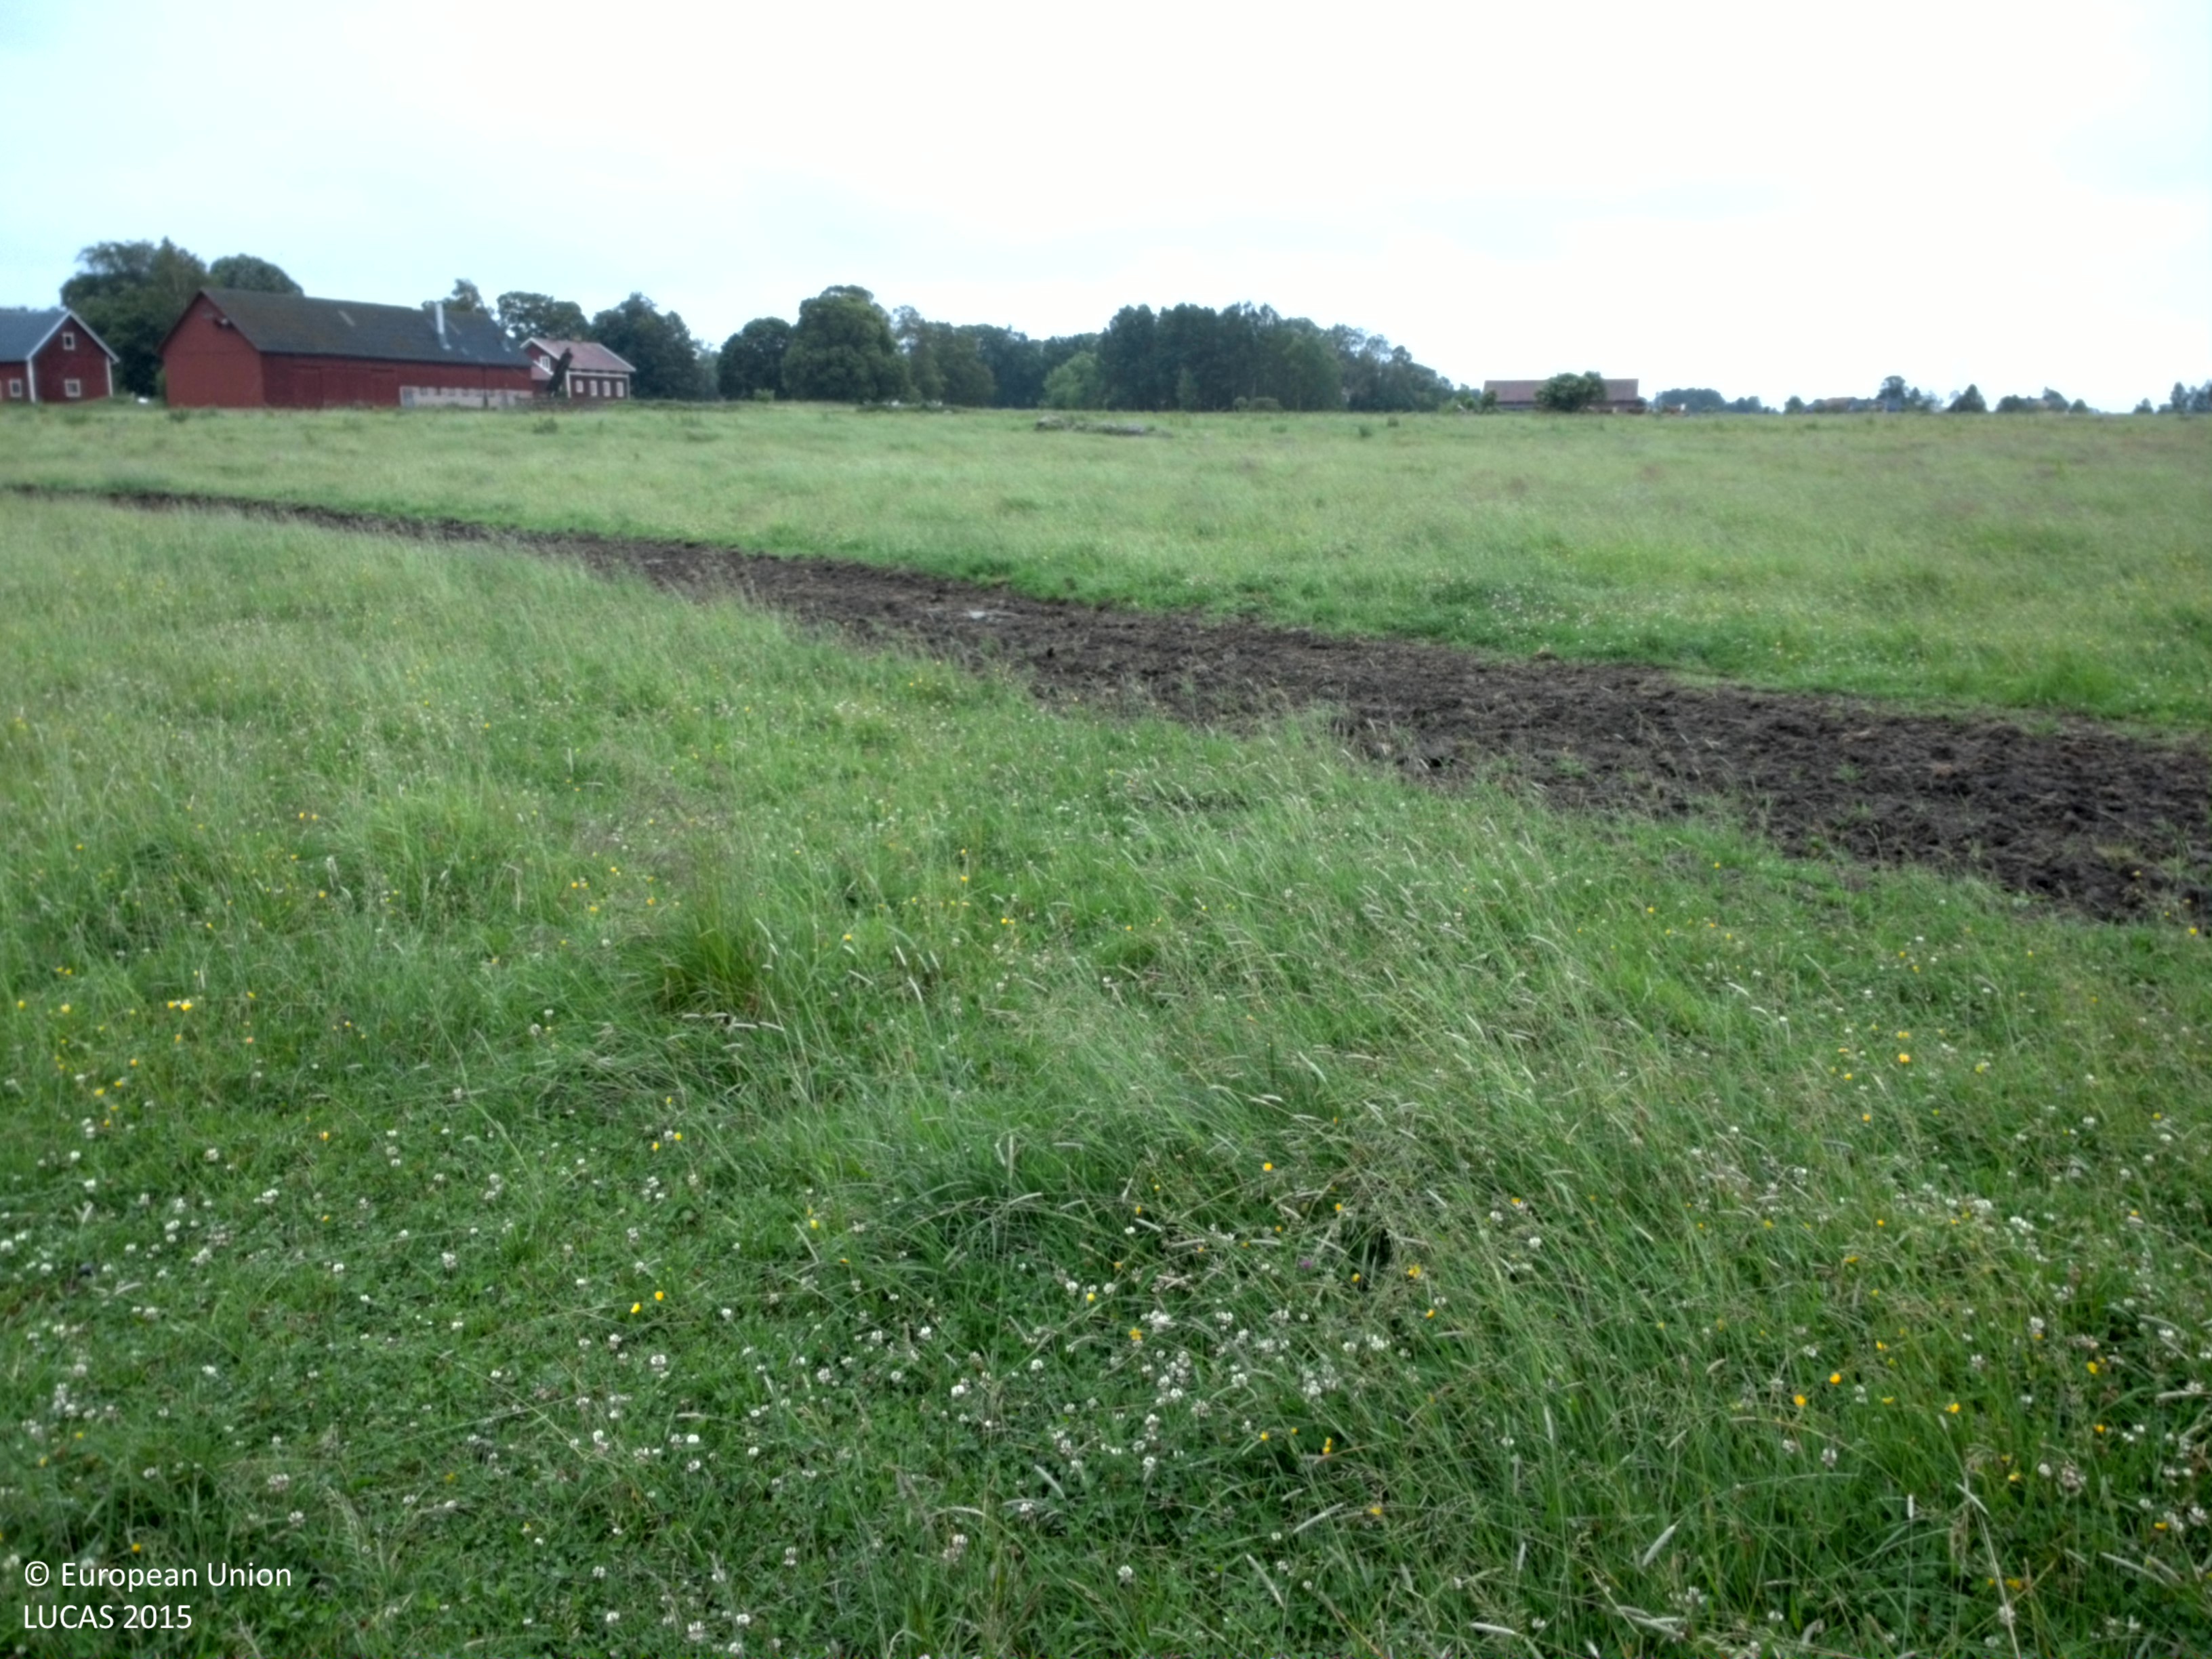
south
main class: Grassland
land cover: Grassland without tree/shrub cover
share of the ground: > 75 %
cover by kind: herbaceous plants 100 %
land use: Agriculture (excluding fallow land and kitchen gardens)
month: July
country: SE
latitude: 58.5564
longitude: 13.9980
